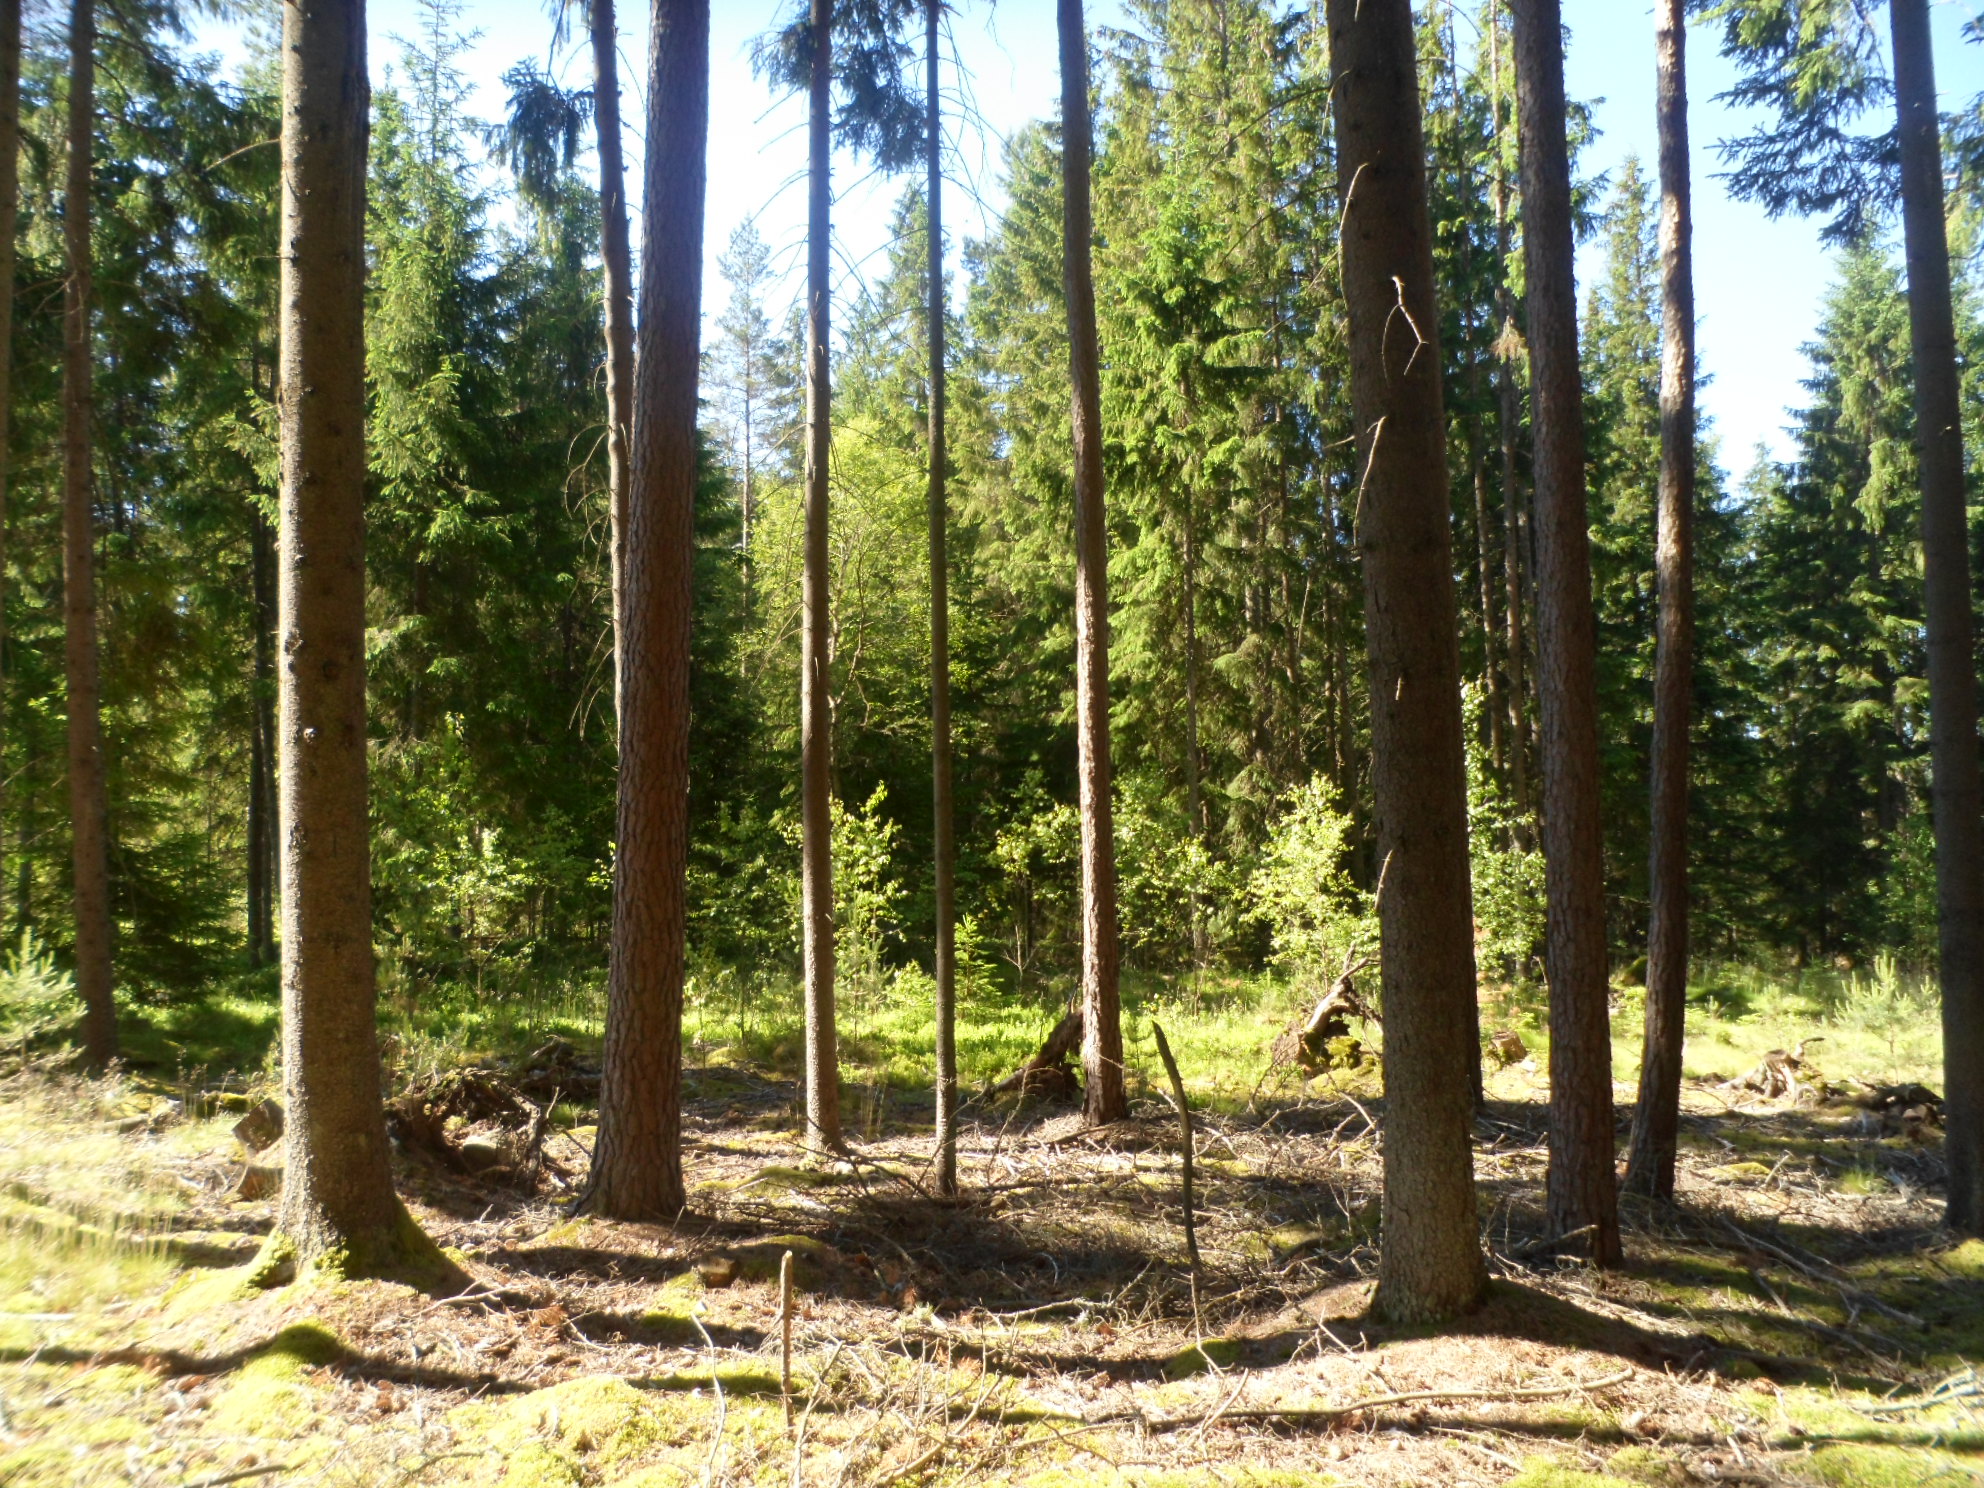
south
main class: Woodland
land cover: Spruce dominated coniferous woodland
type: boreal forest
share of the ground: > 75 %
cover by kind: coniferous forest trees 75 %, lichens and mosses 15 %, shrubs 5 %, herbaceous plants 5 %
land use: Forestry
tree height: > 5 m
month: July
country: SE
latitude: 57.0264
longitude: 14.5270
